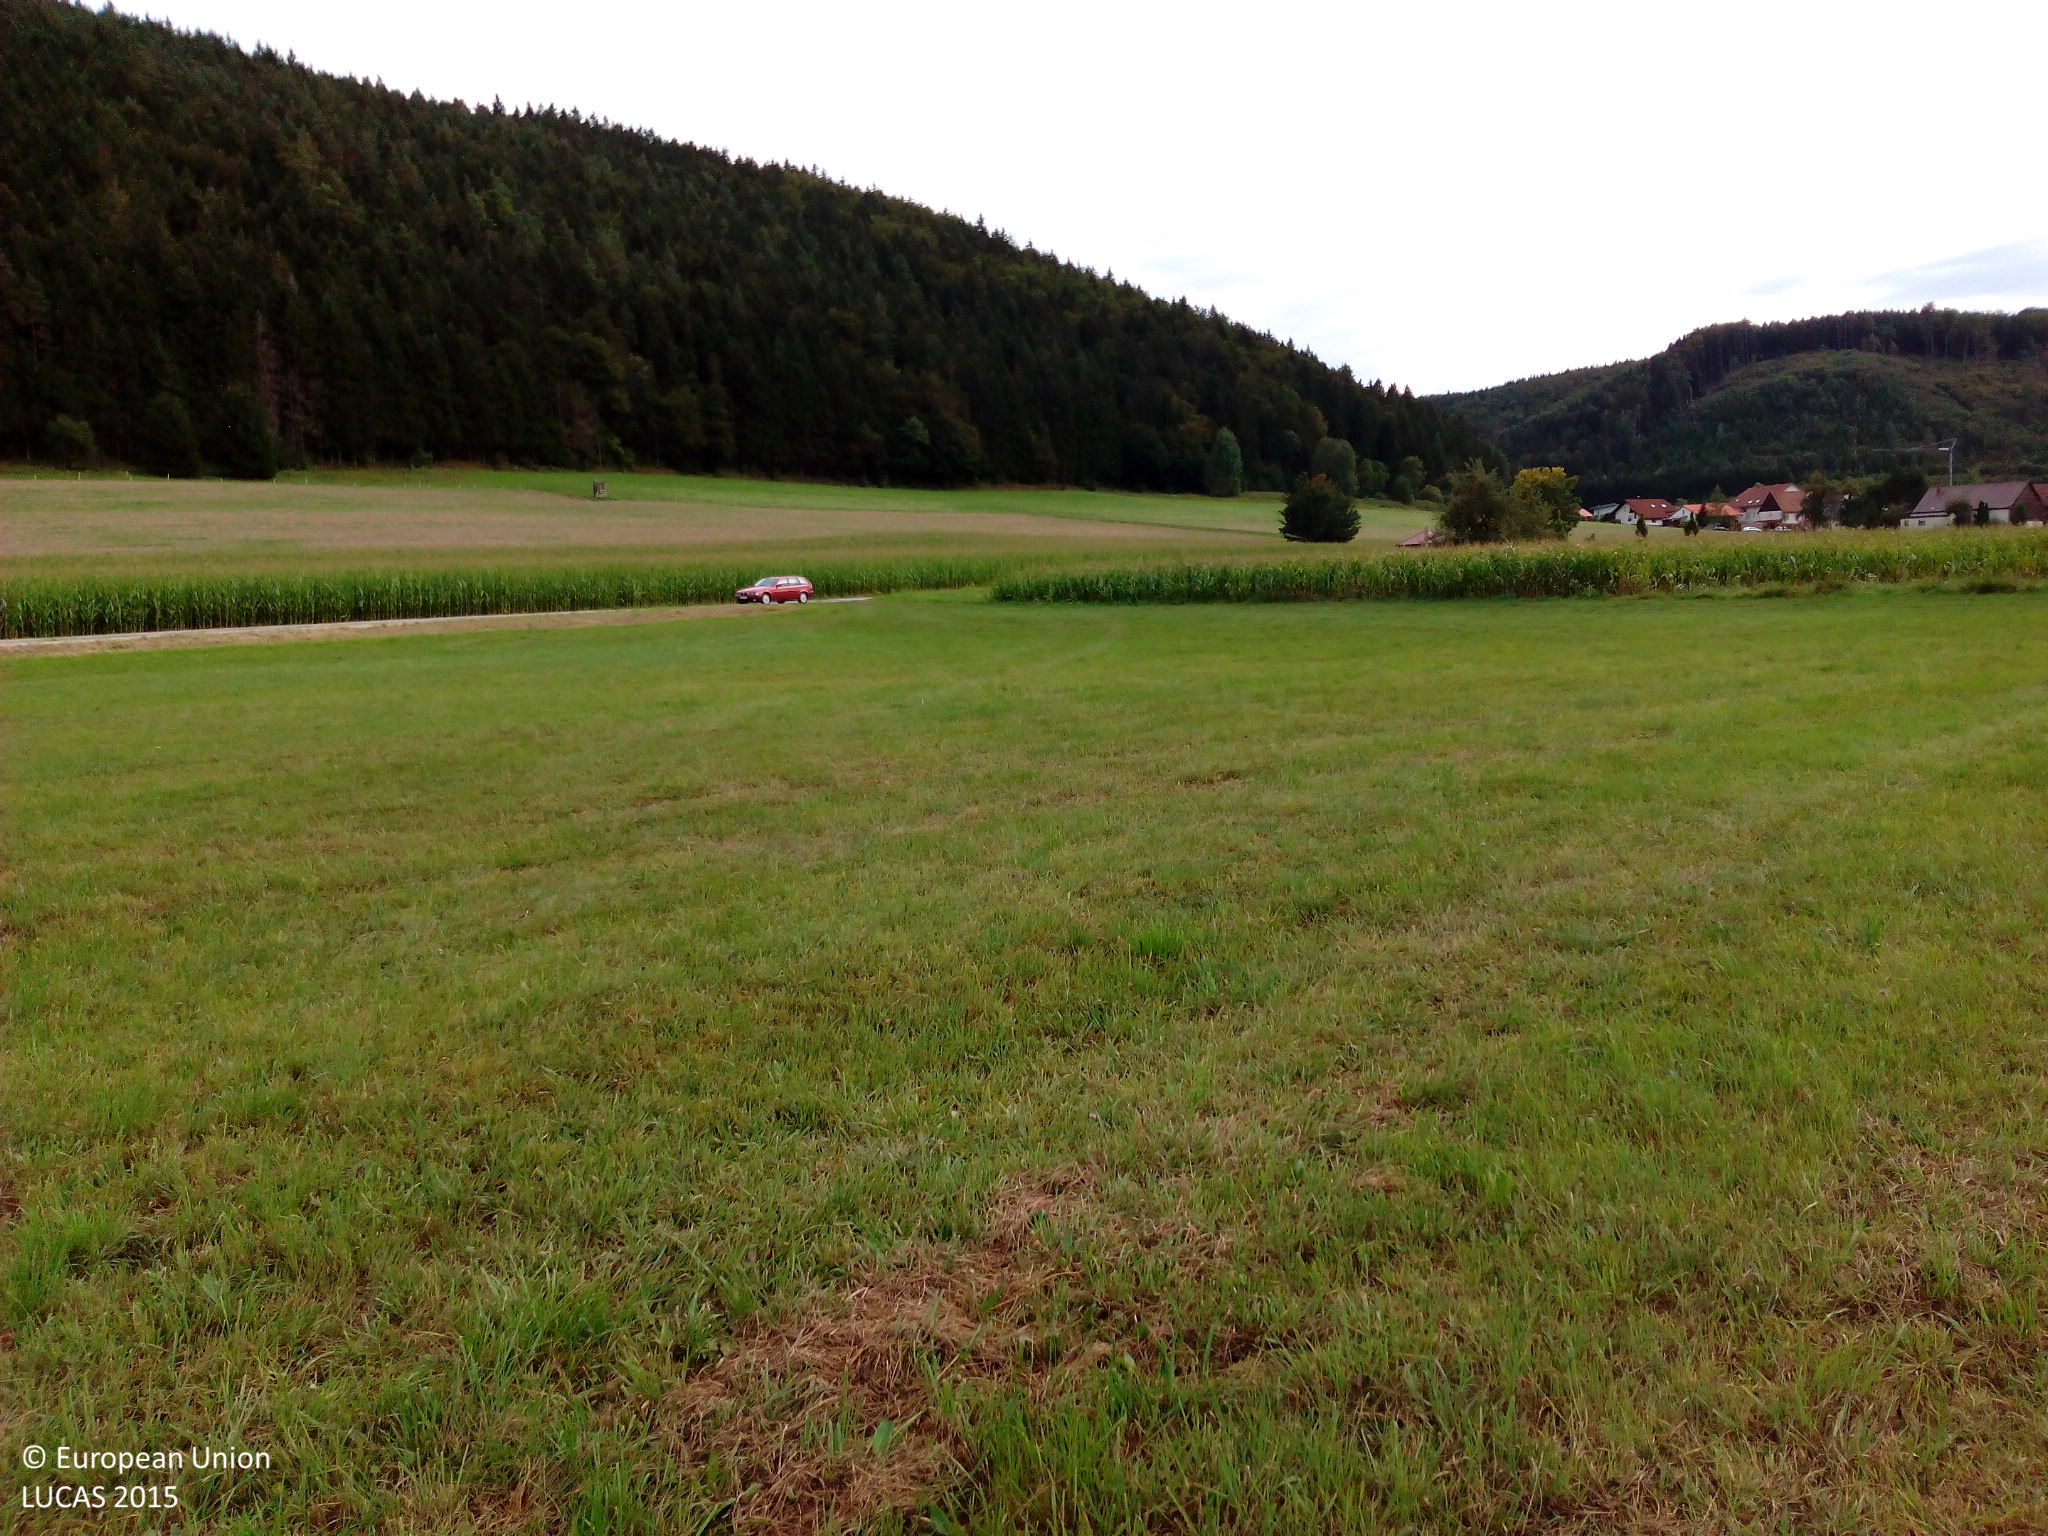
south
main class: Grassland
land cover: Grassland without tree/shrub cover
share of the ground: > 75 %
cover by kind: herbaceous plants 95 %, unconsolidated bare surface 5 %
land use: Agriculture (excluding fallow land and kitchen gardens)
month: September
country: DE
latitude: 47.9279
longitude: 8.7026
